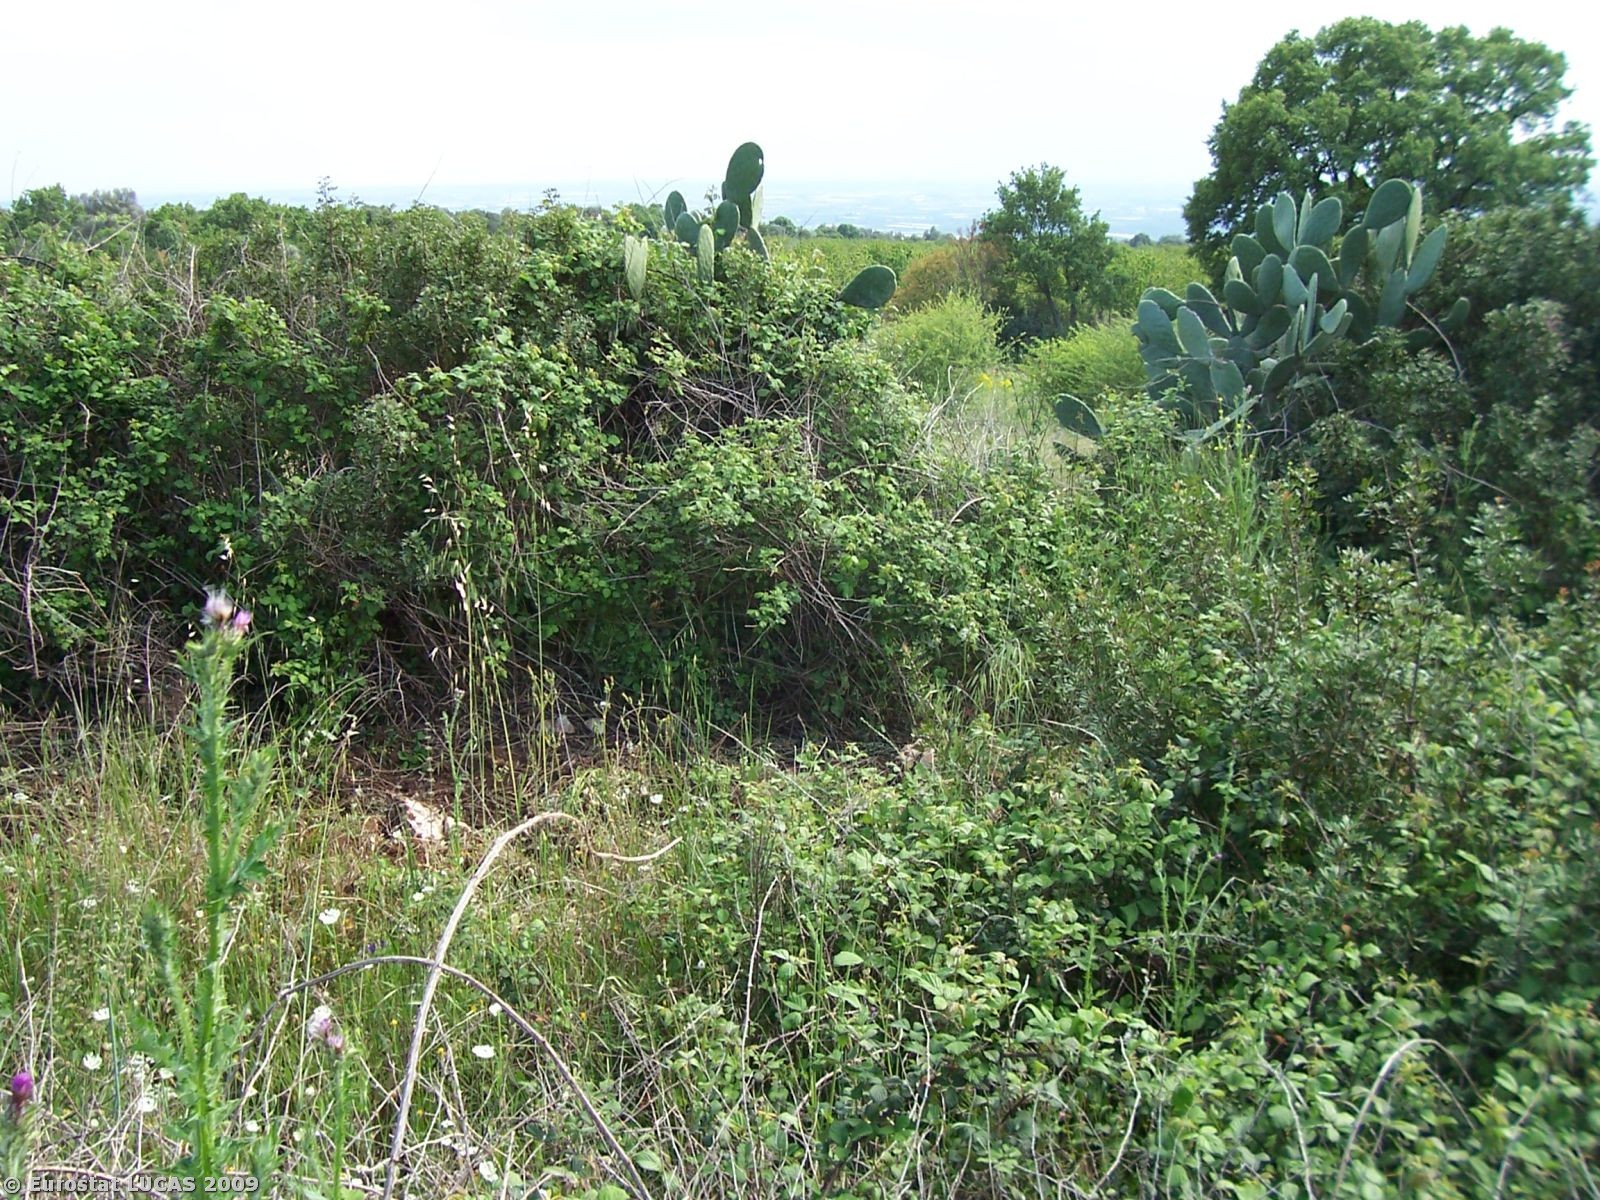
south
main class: Shrubland
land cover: Shrubland without tree cover
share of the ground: > 75 %
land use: Nature reserves
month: May
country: IT
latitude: 40.5911
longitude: 16.8413
